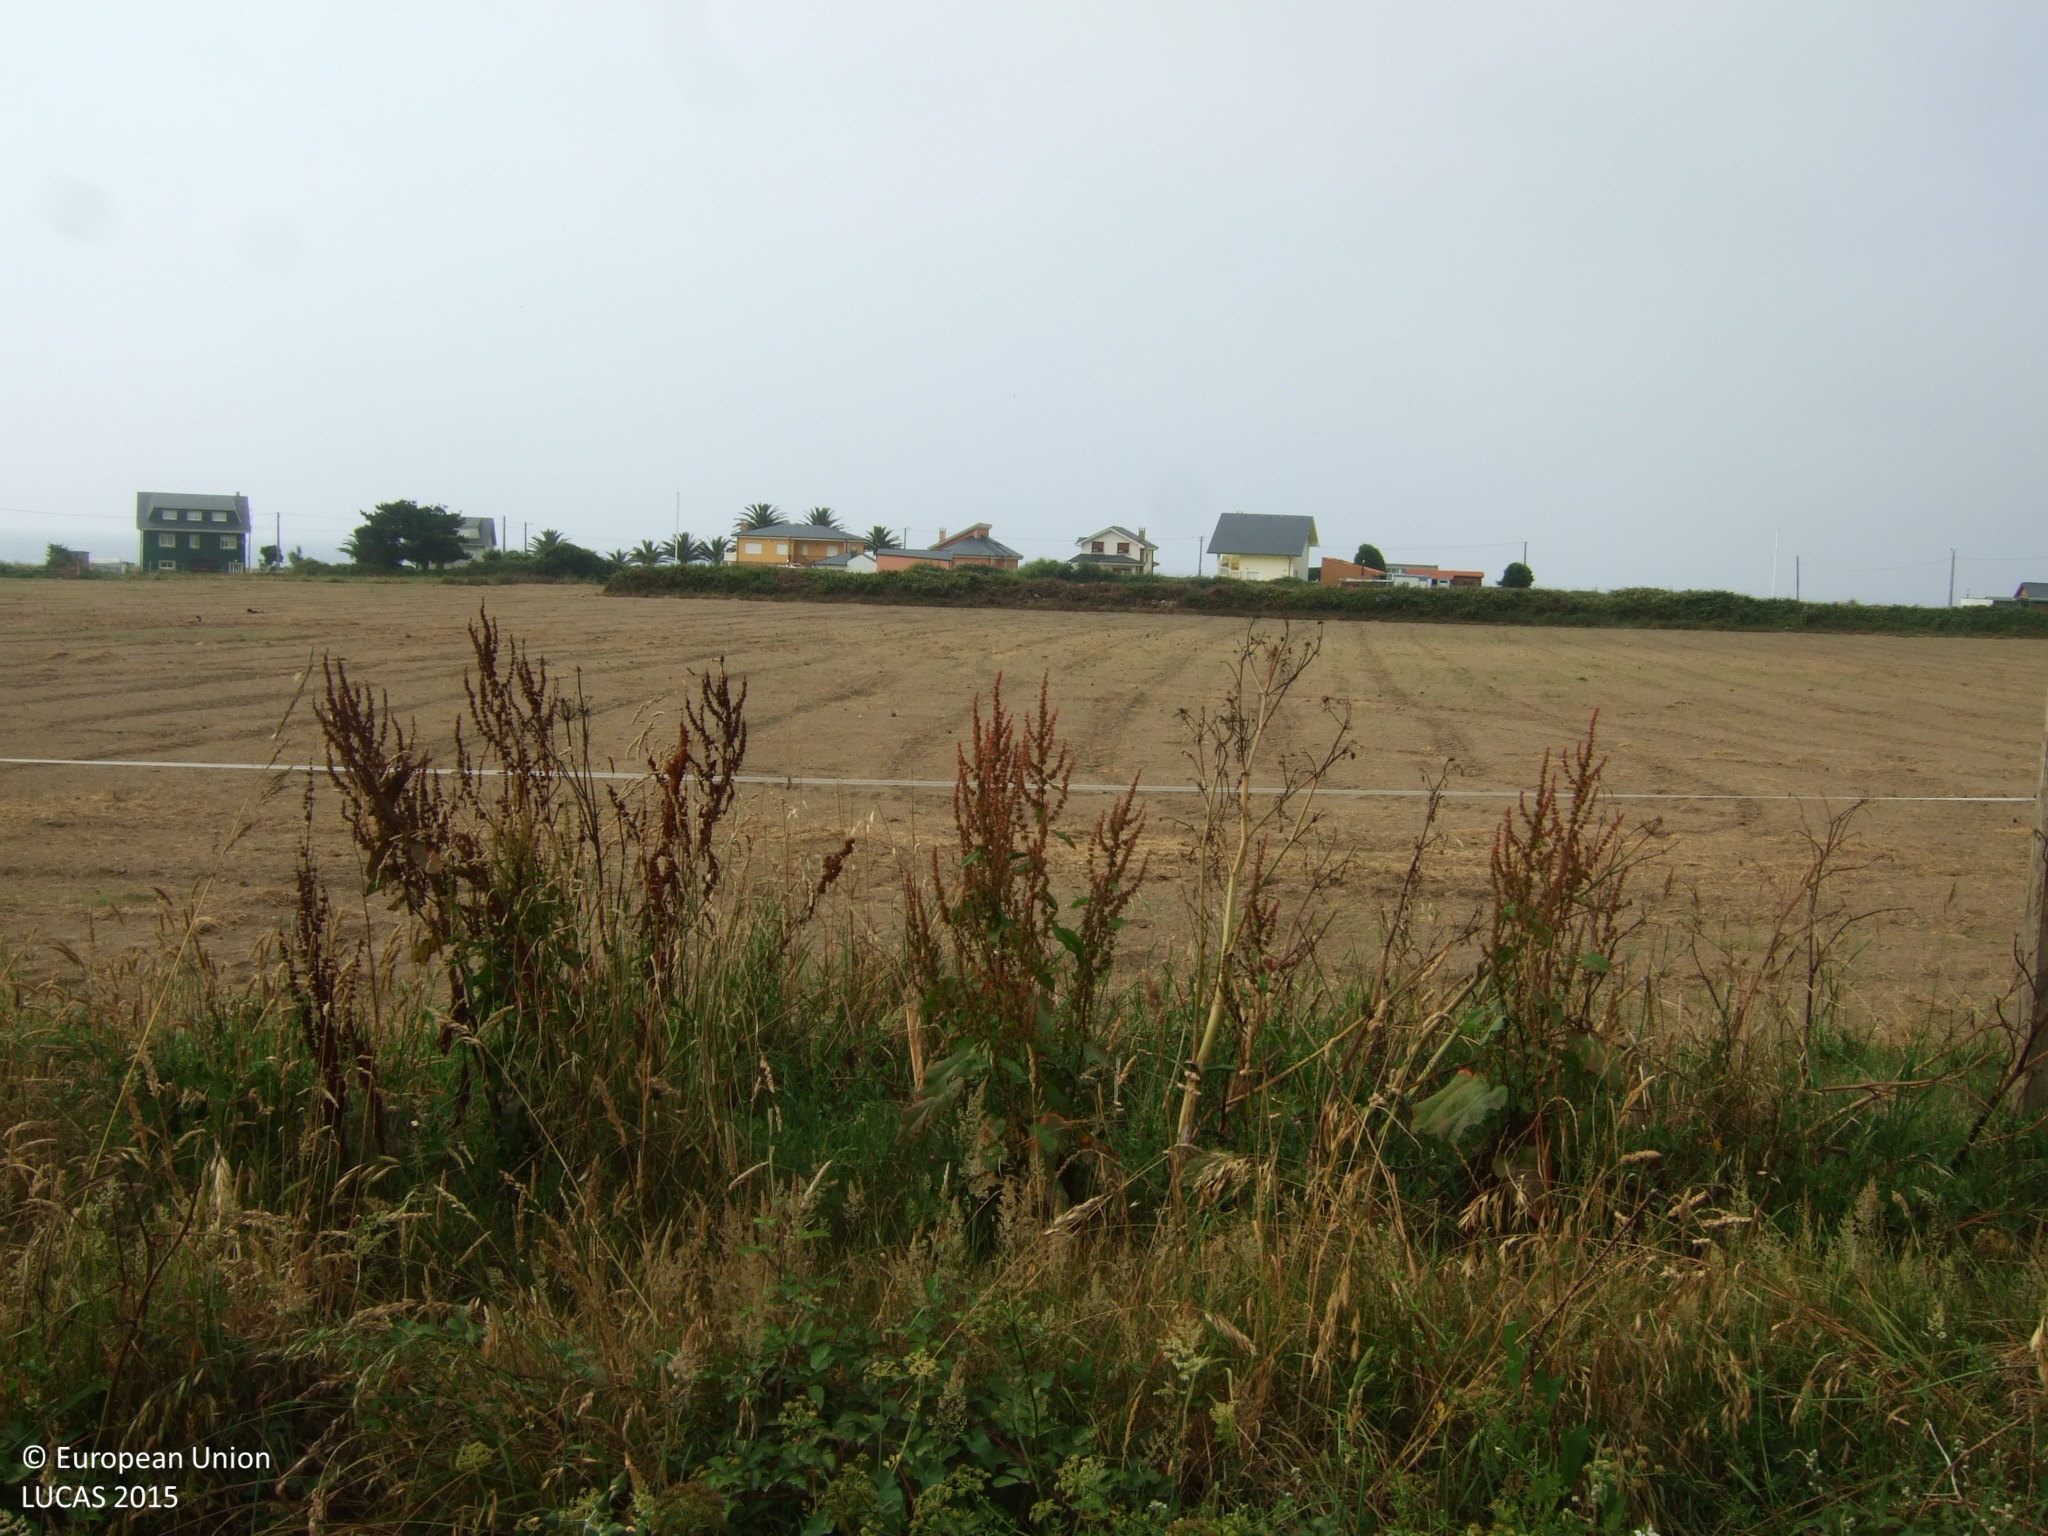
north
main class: Cropland
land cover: Maize
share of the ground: 50 - 75 %
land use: Agriculture (excluding fallow land and kitchen gardens)
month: June
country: ES
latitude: 43.5604
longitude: -7.2206
